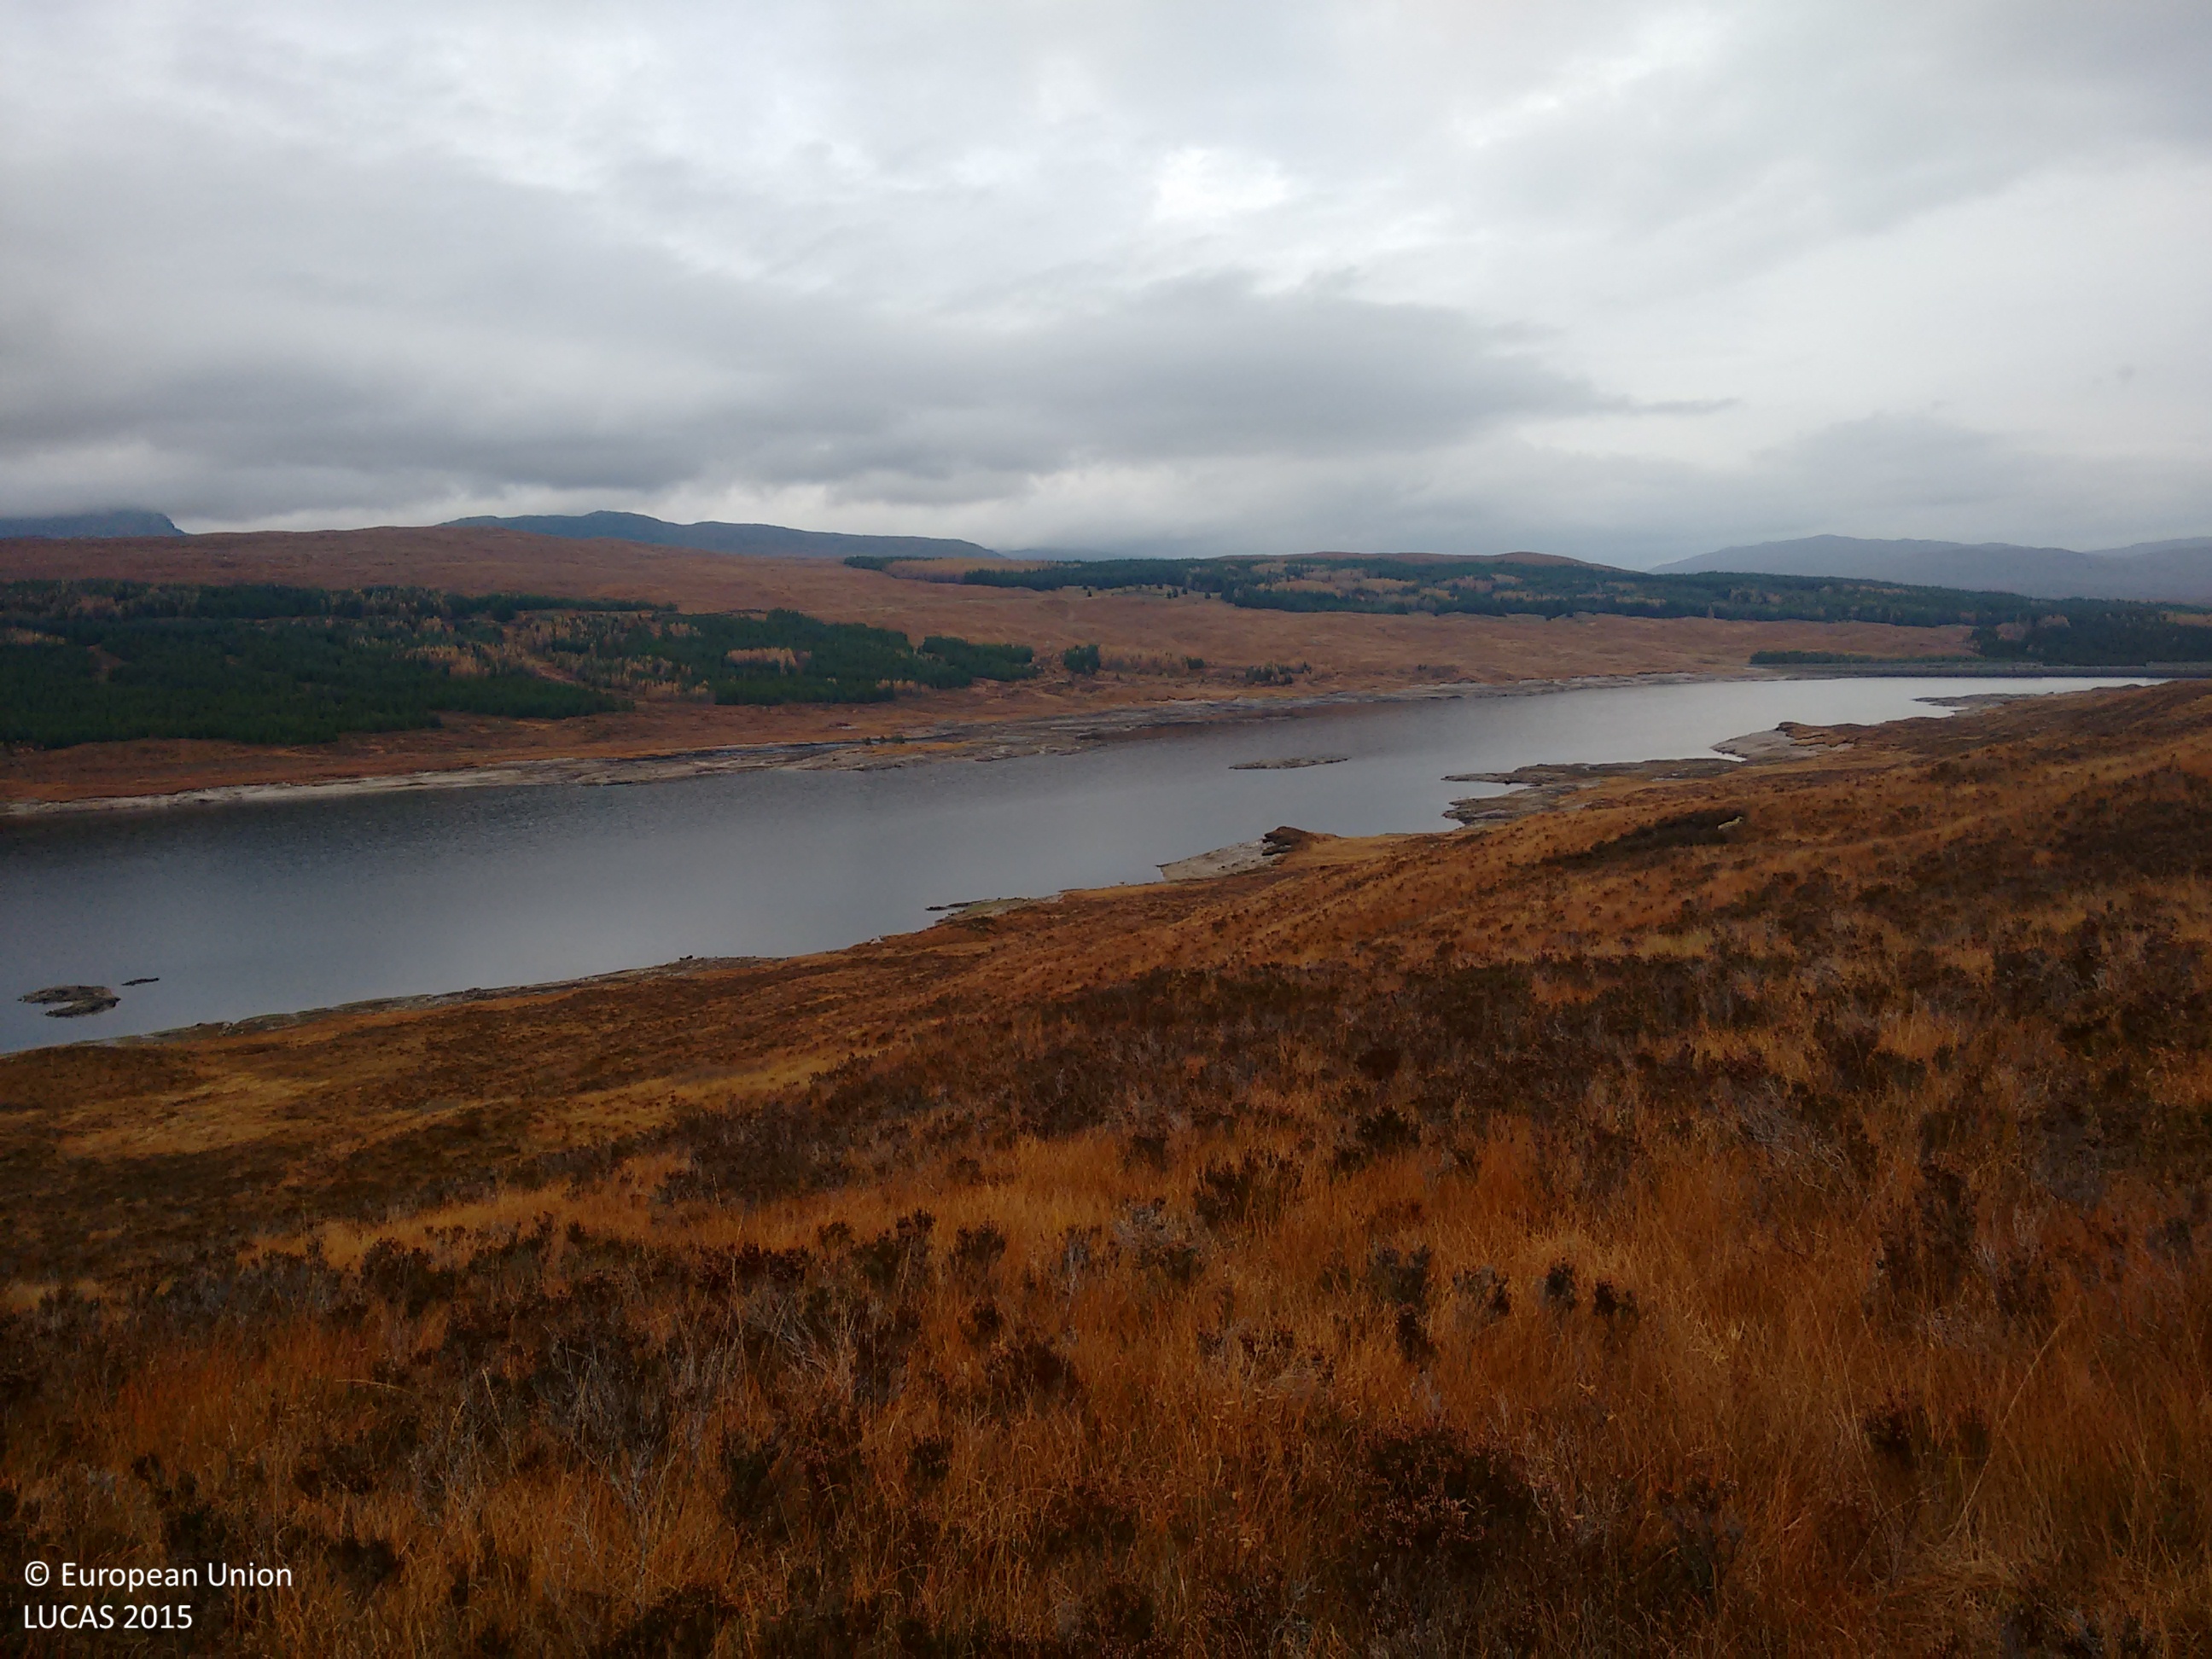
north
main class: Shrubland
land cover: Shrubland without tree cover
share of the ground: > 75 %
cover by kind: shrubs 70 %, herbaceous plants 20 %, lichens and mosses 10 %
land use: Agriculture (excluding fallow land and kitchen gardens)
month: November
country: GB
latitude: 57.1157
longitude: -4.9834
